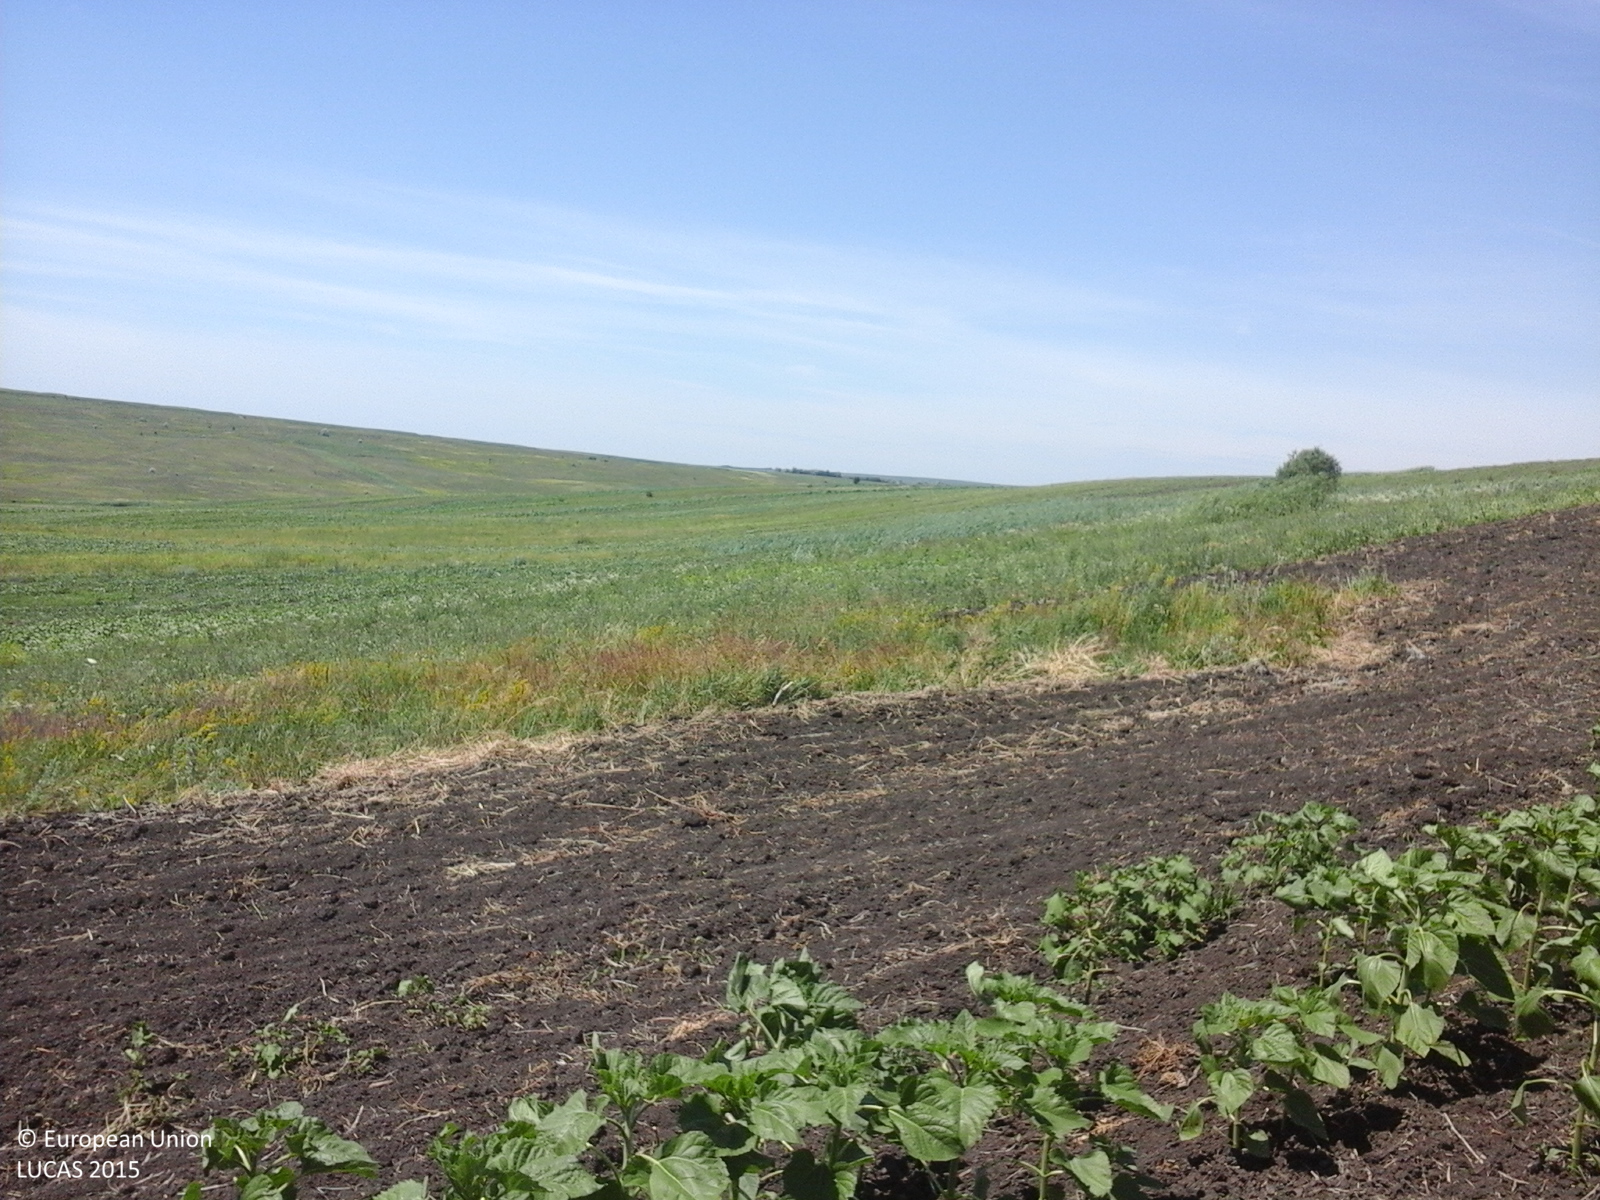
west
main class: Cropland
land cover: Sunflower
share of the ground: 25 - 50 %
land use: Agriculture (excluding fallow land and kitchen gardens)
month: June
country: RO
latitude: 48.1114
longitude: 26.7135
